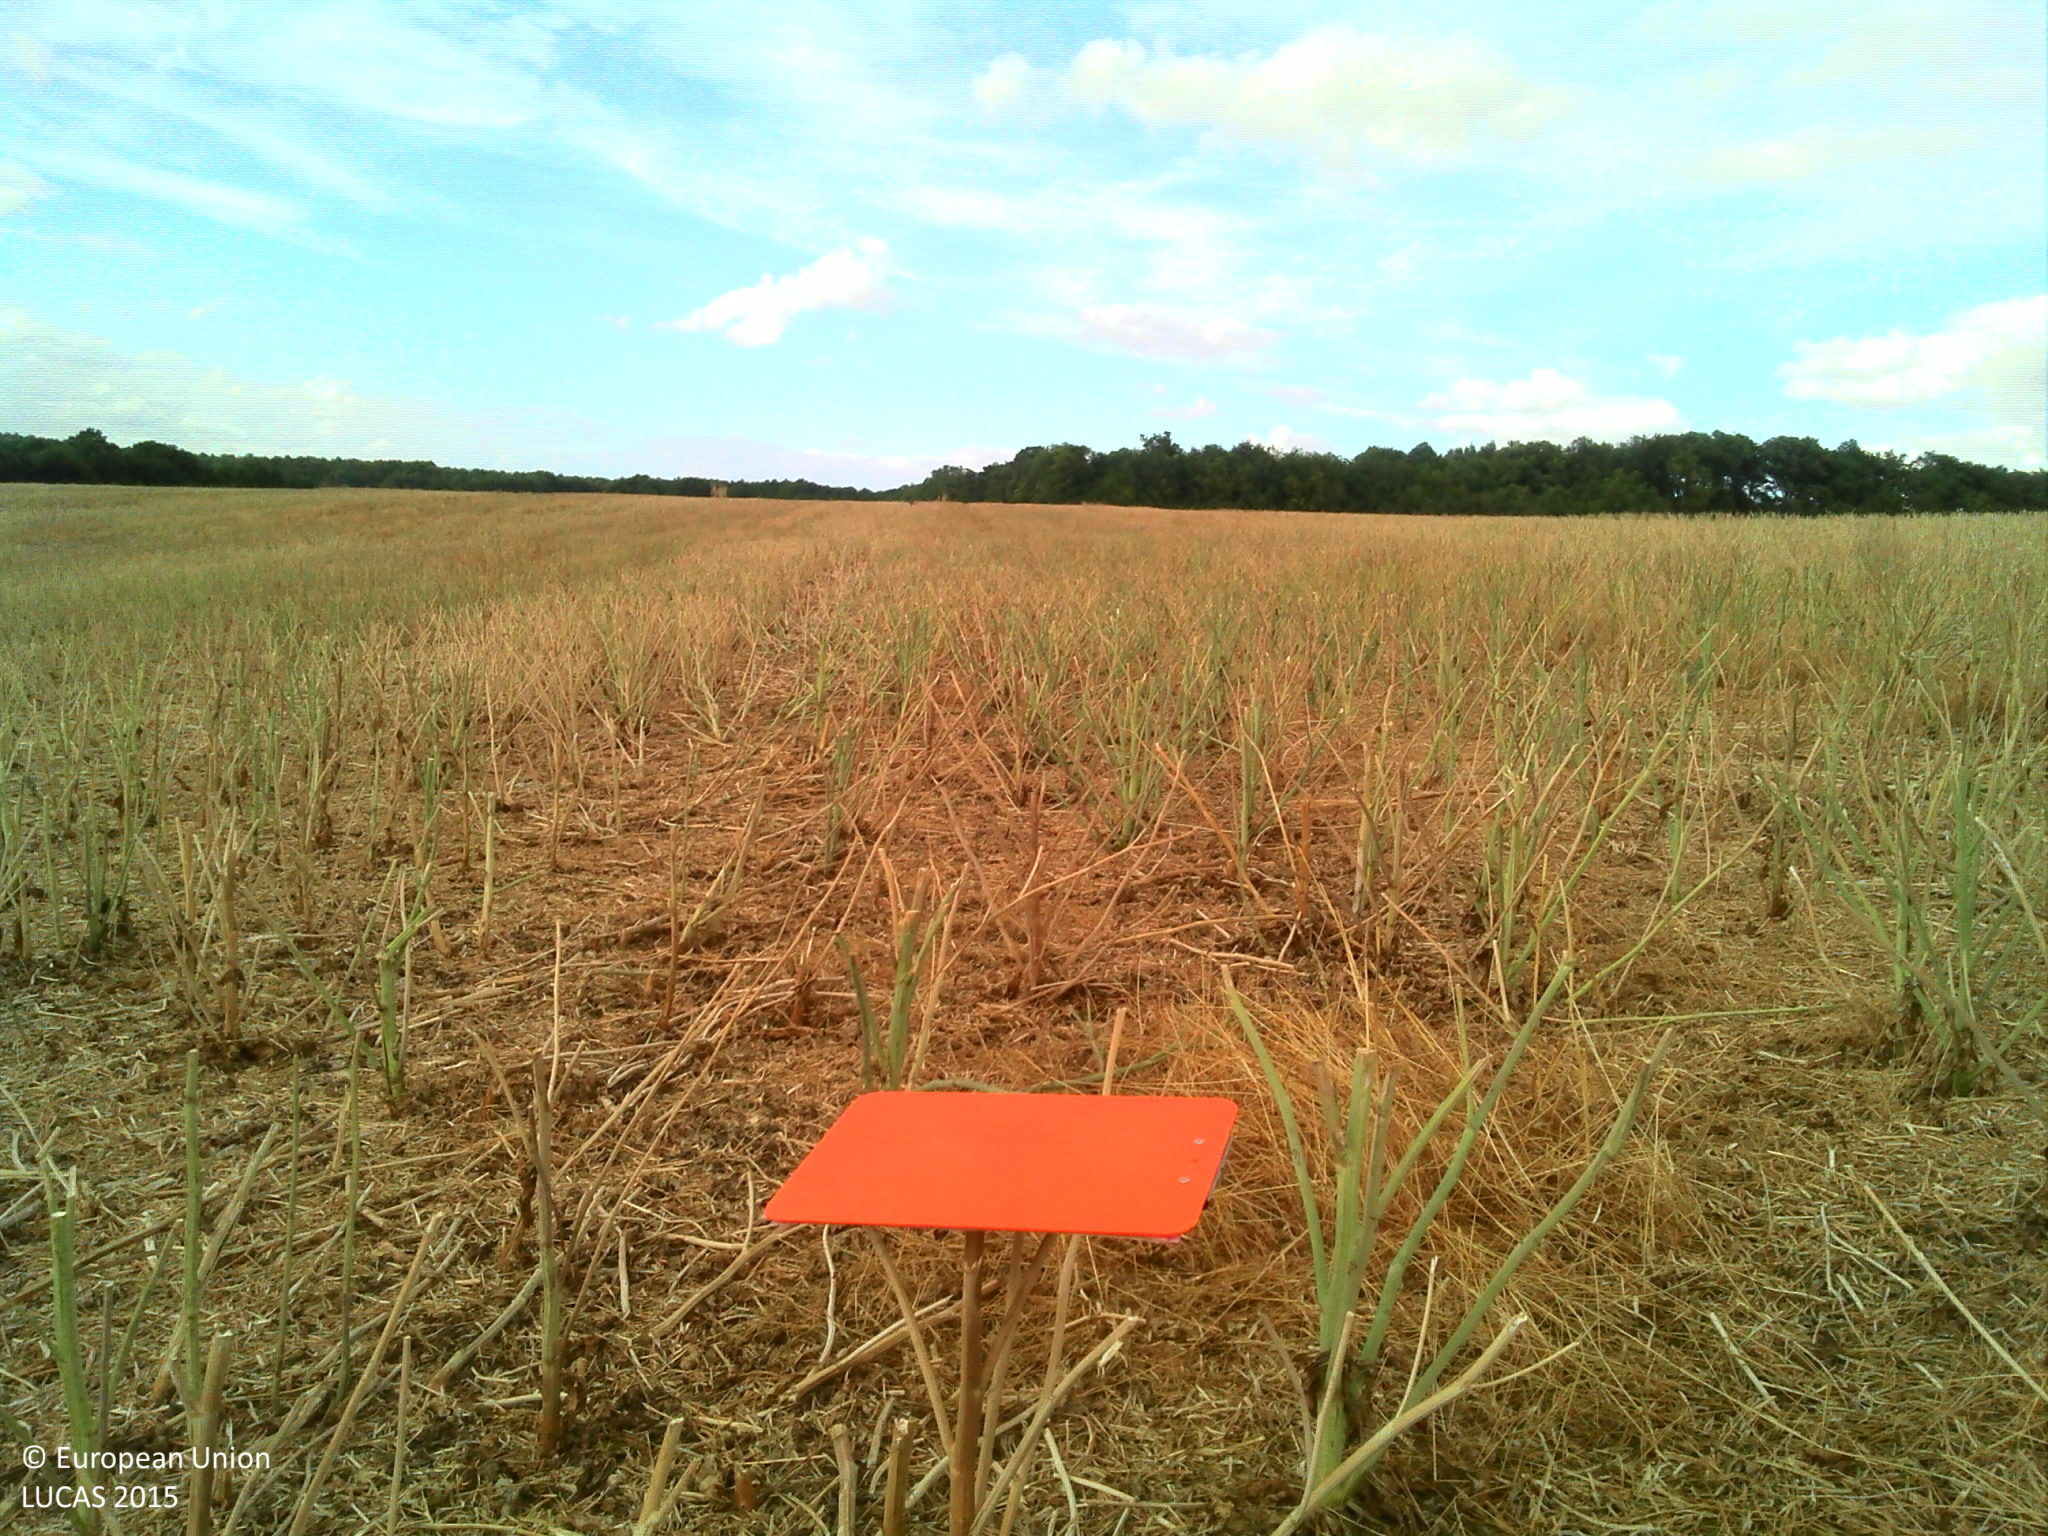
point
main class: Cropland
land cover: Rape and turnip rape
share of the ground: > 75 %
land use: Agriculture (excluding fallow land and kitchen gardens)
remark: Harvested field
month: July
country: FR
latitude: 47.9888
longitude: 1.3136
